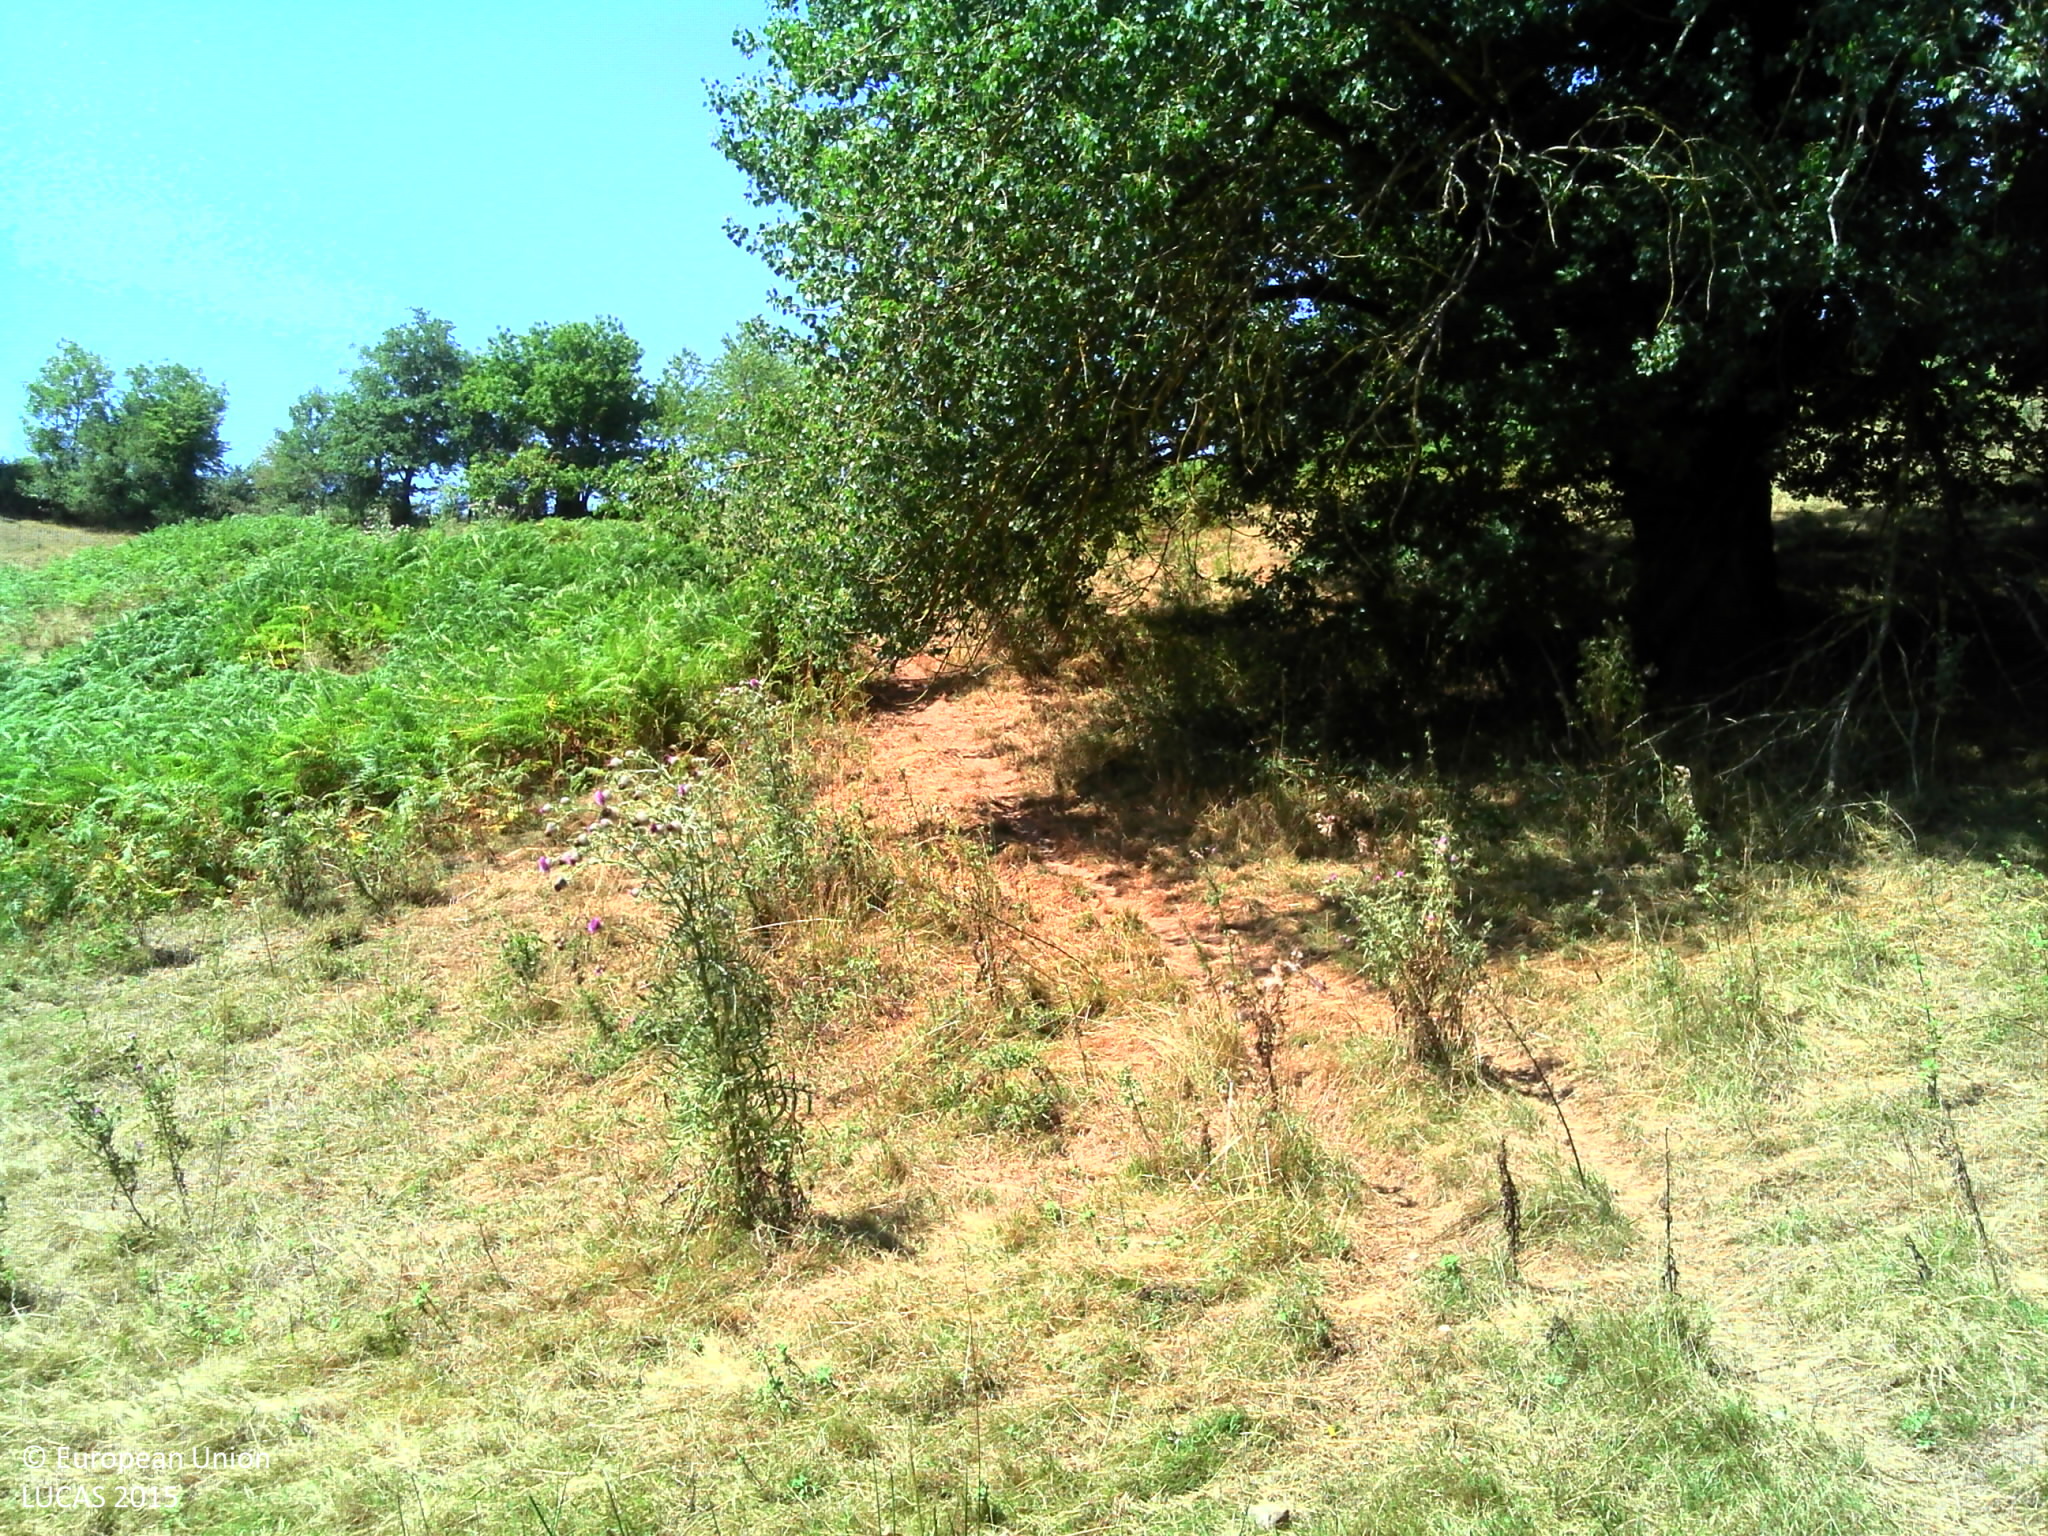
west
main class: Grassland
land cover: Grassland without tree/shrub cover
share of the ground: > 75 %
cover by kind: herbaceous plants 100 %
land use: Agriculture (excluding fallow land and kitchen gardens)
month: August
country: FR
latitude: 43.9784
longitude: 2.6126
